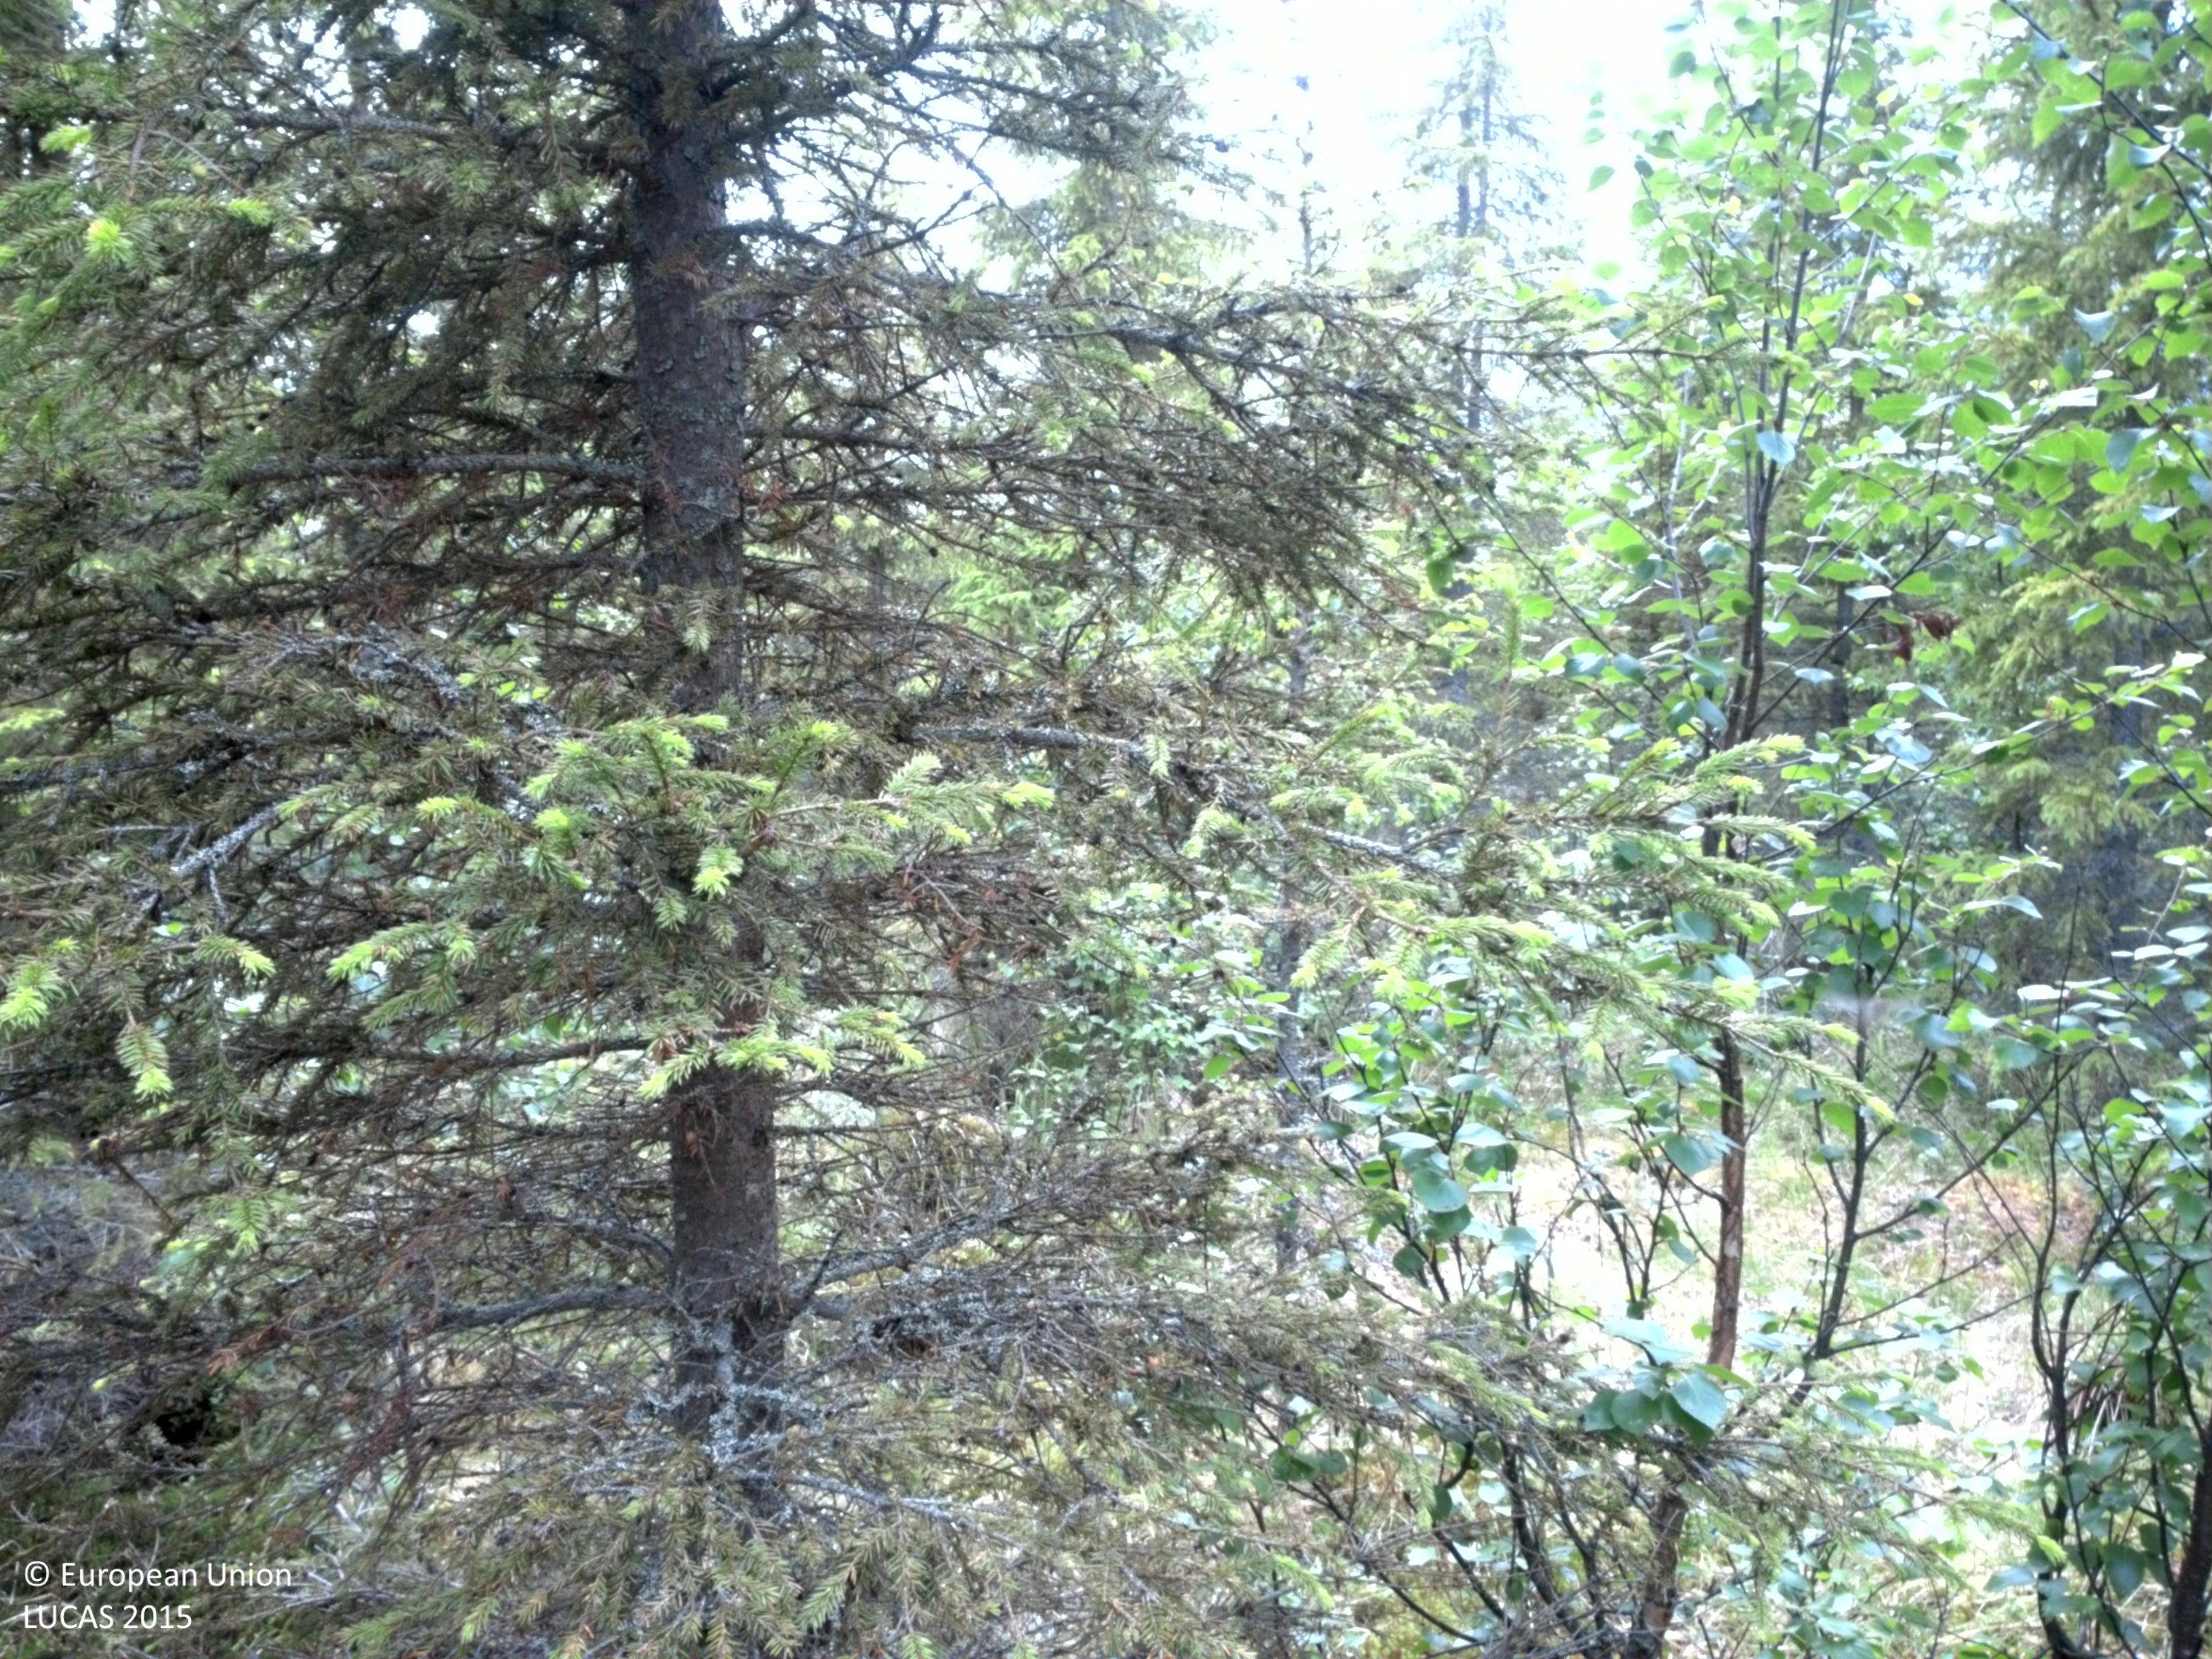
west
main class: Woodland
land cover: Spruce dominated mixed woodland
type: boreal forest
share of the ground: 50 - 75 %
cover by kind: coniferous forest trees 45 %, broadleaved forest trees 15 %, shrubs 15 %, herbaceous plants 15 %, lichens and mosses 10 %
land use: Forestry
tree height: > 5 m
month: July
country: SE
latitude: 64.4438
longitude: 18.1330
